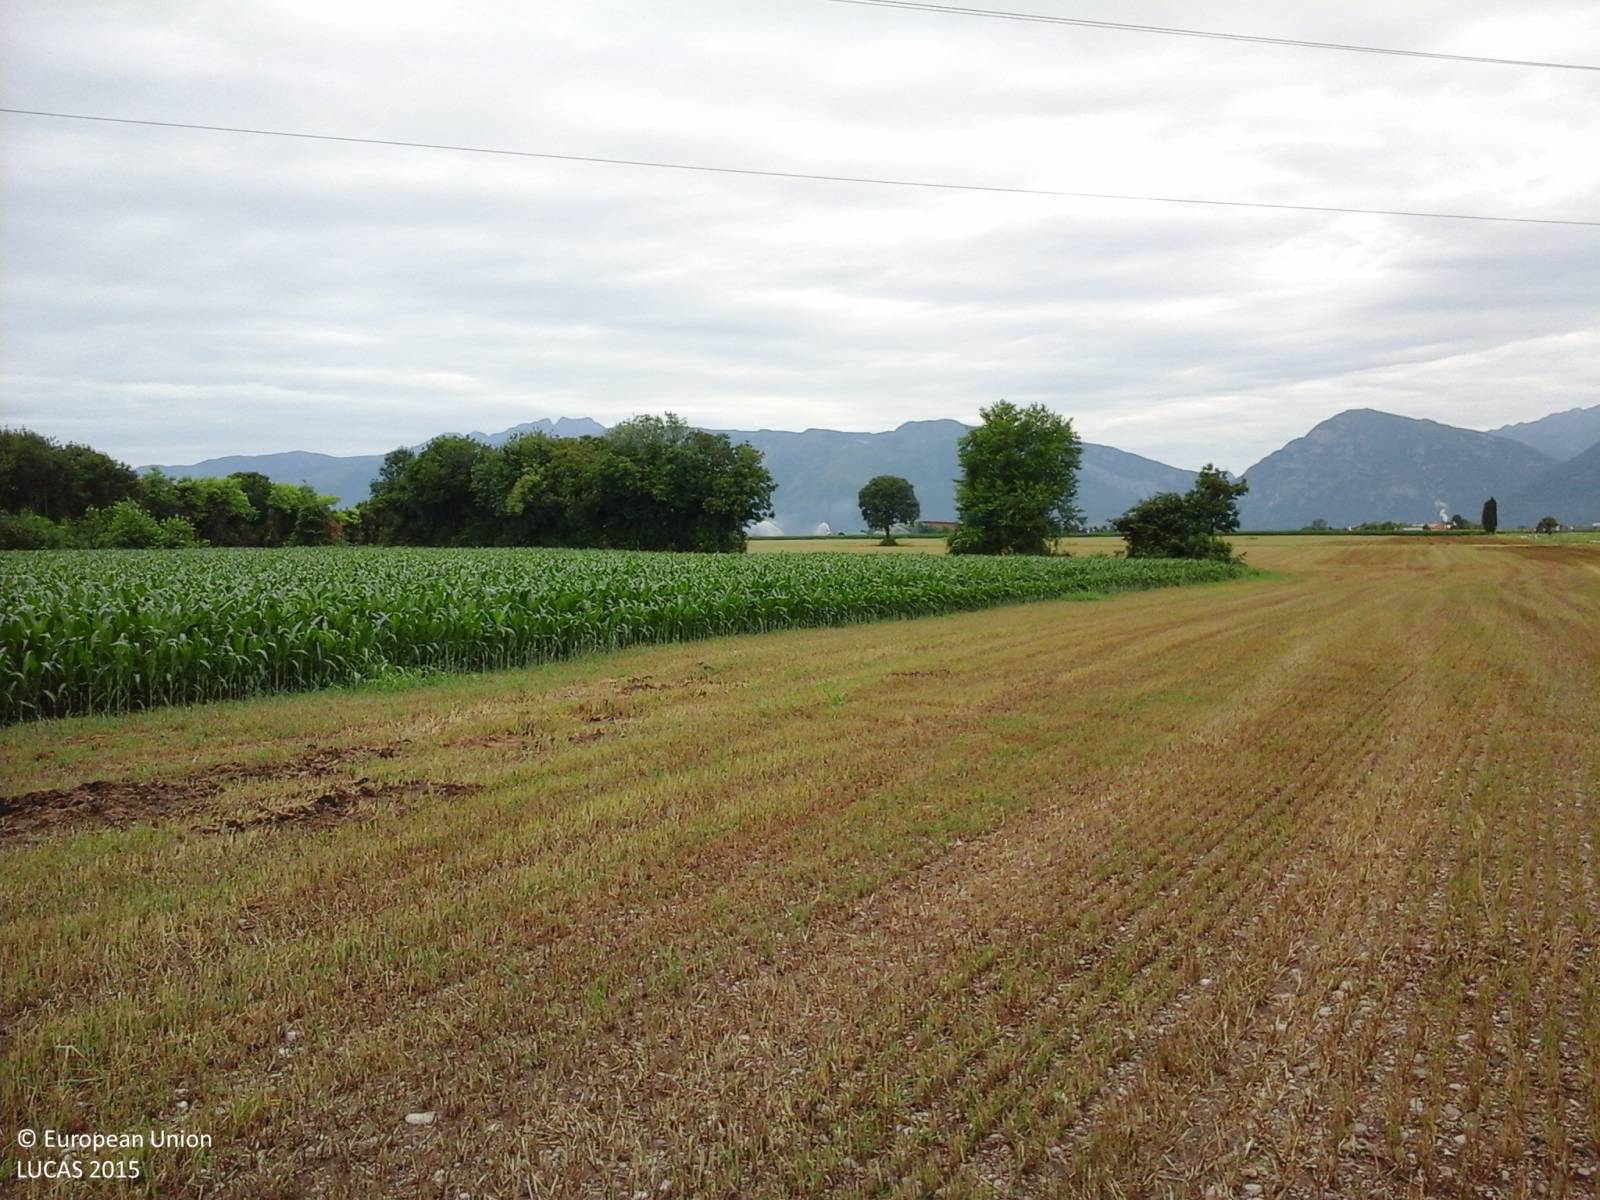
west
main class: Cropland
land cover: Common wheat
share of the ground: < 10 %
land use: Agriculture (excluding fallow land and kitchen gardens)
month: June
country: IT
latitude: 46.1169
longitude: 12.7788
